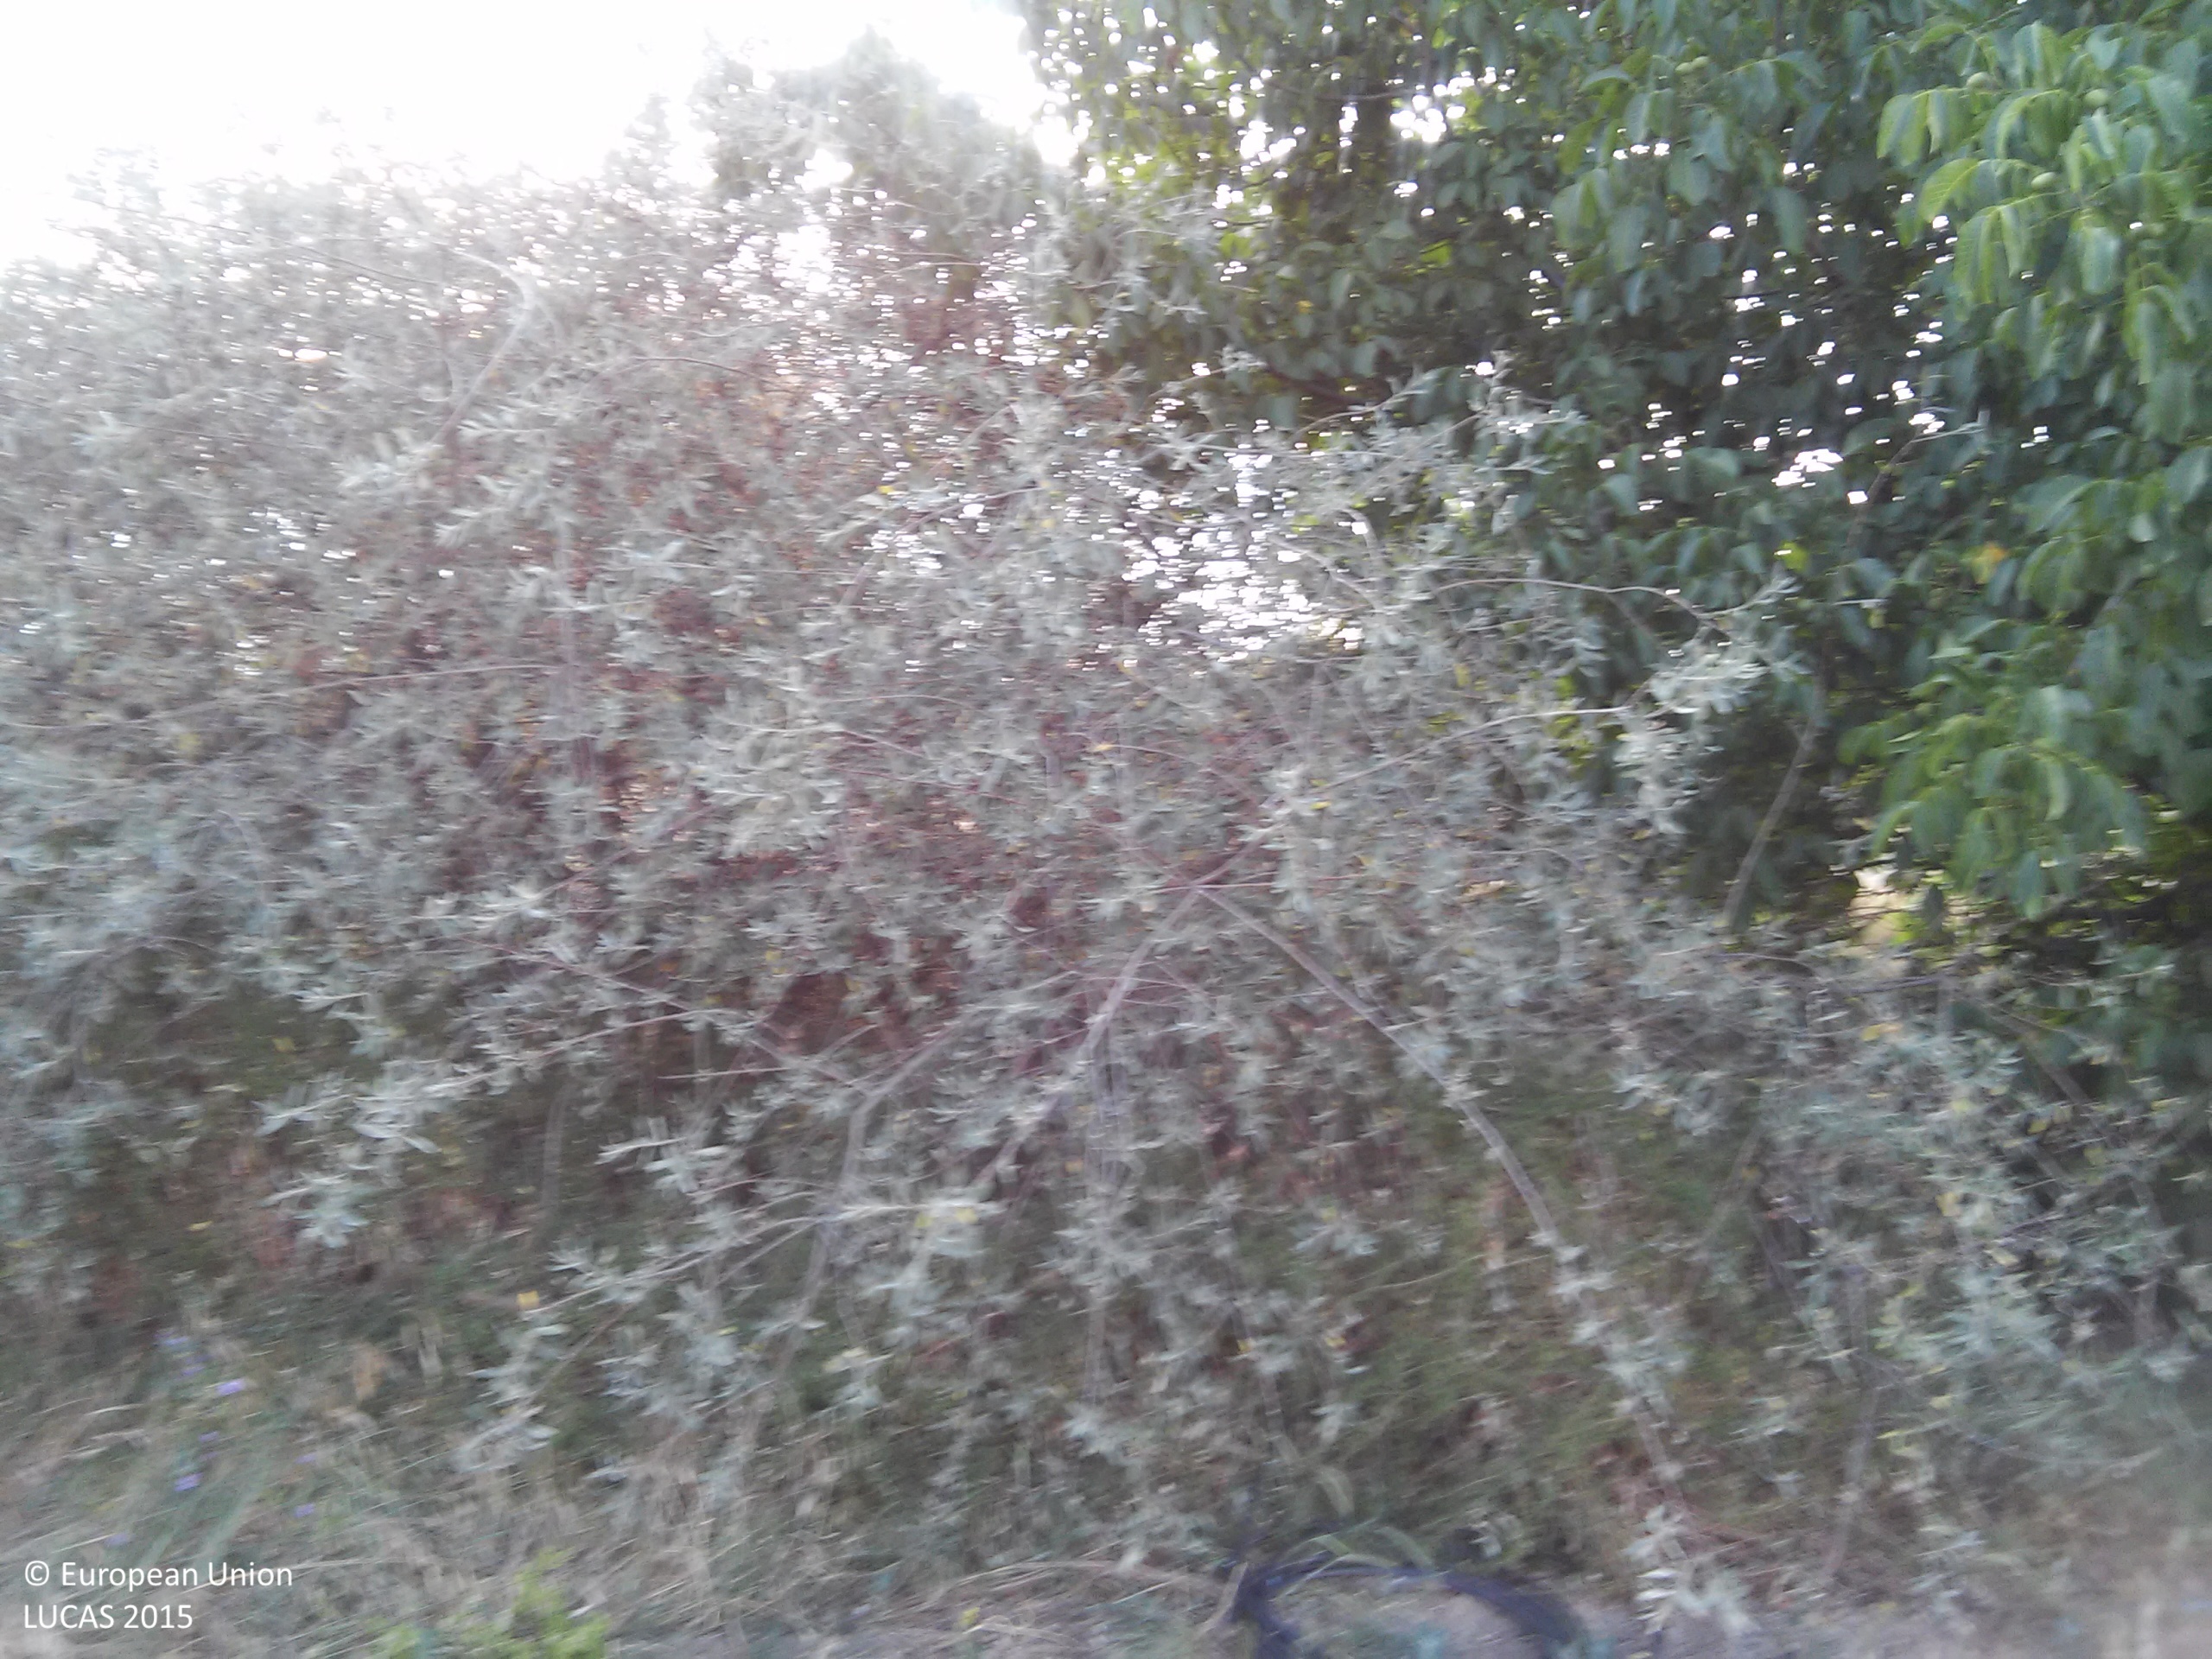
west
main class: Cropland
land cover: Nuts trees
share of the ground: < 10 %
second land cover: Other bare soil
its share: > 75 %
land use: Agriculture (excluding fallow land and kitchen gardens)
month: June
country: ES
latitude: 42.4365
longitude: -5.5452
